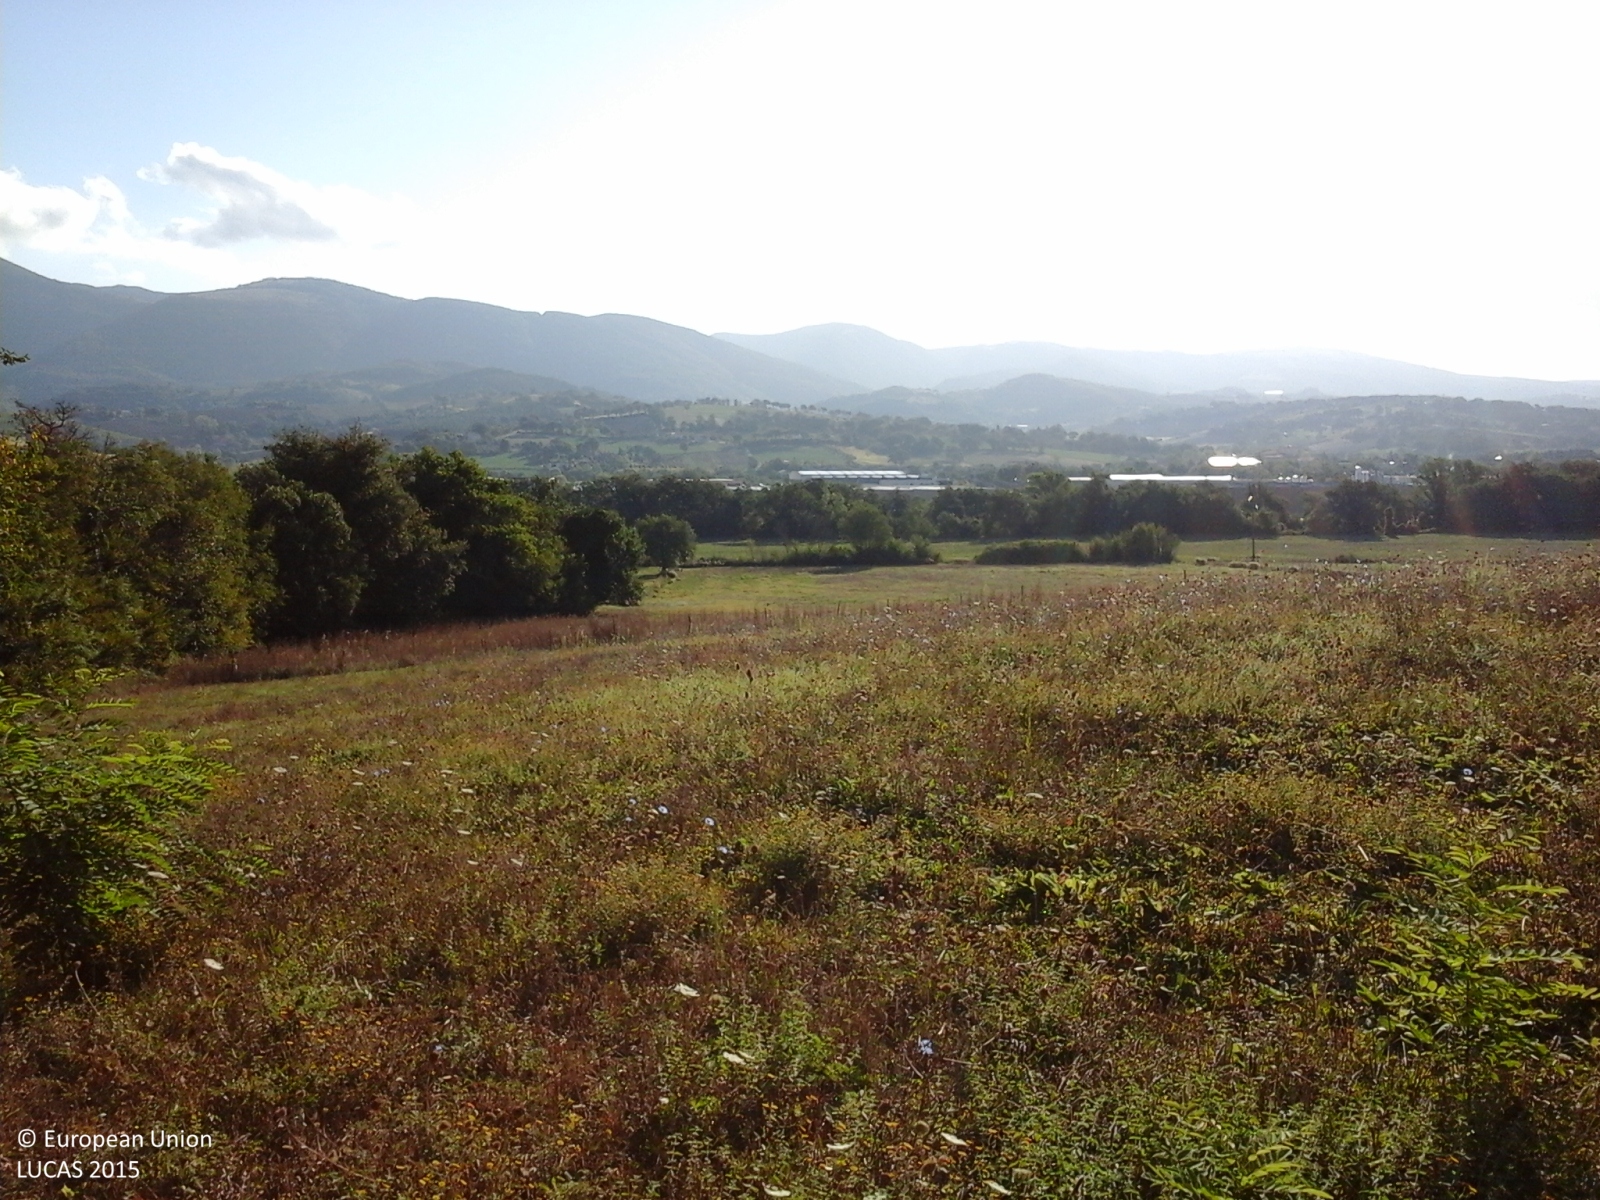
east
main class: Cropland
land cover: Durum wheat
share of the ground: < 10 %
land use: Agriculture (excluding fallow land and kitchen gardens)
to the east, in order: Durum wheat; Fences; Spontaneously vegetated surfaces
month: September
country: IT
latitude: 43.2785
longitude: 12.9864
